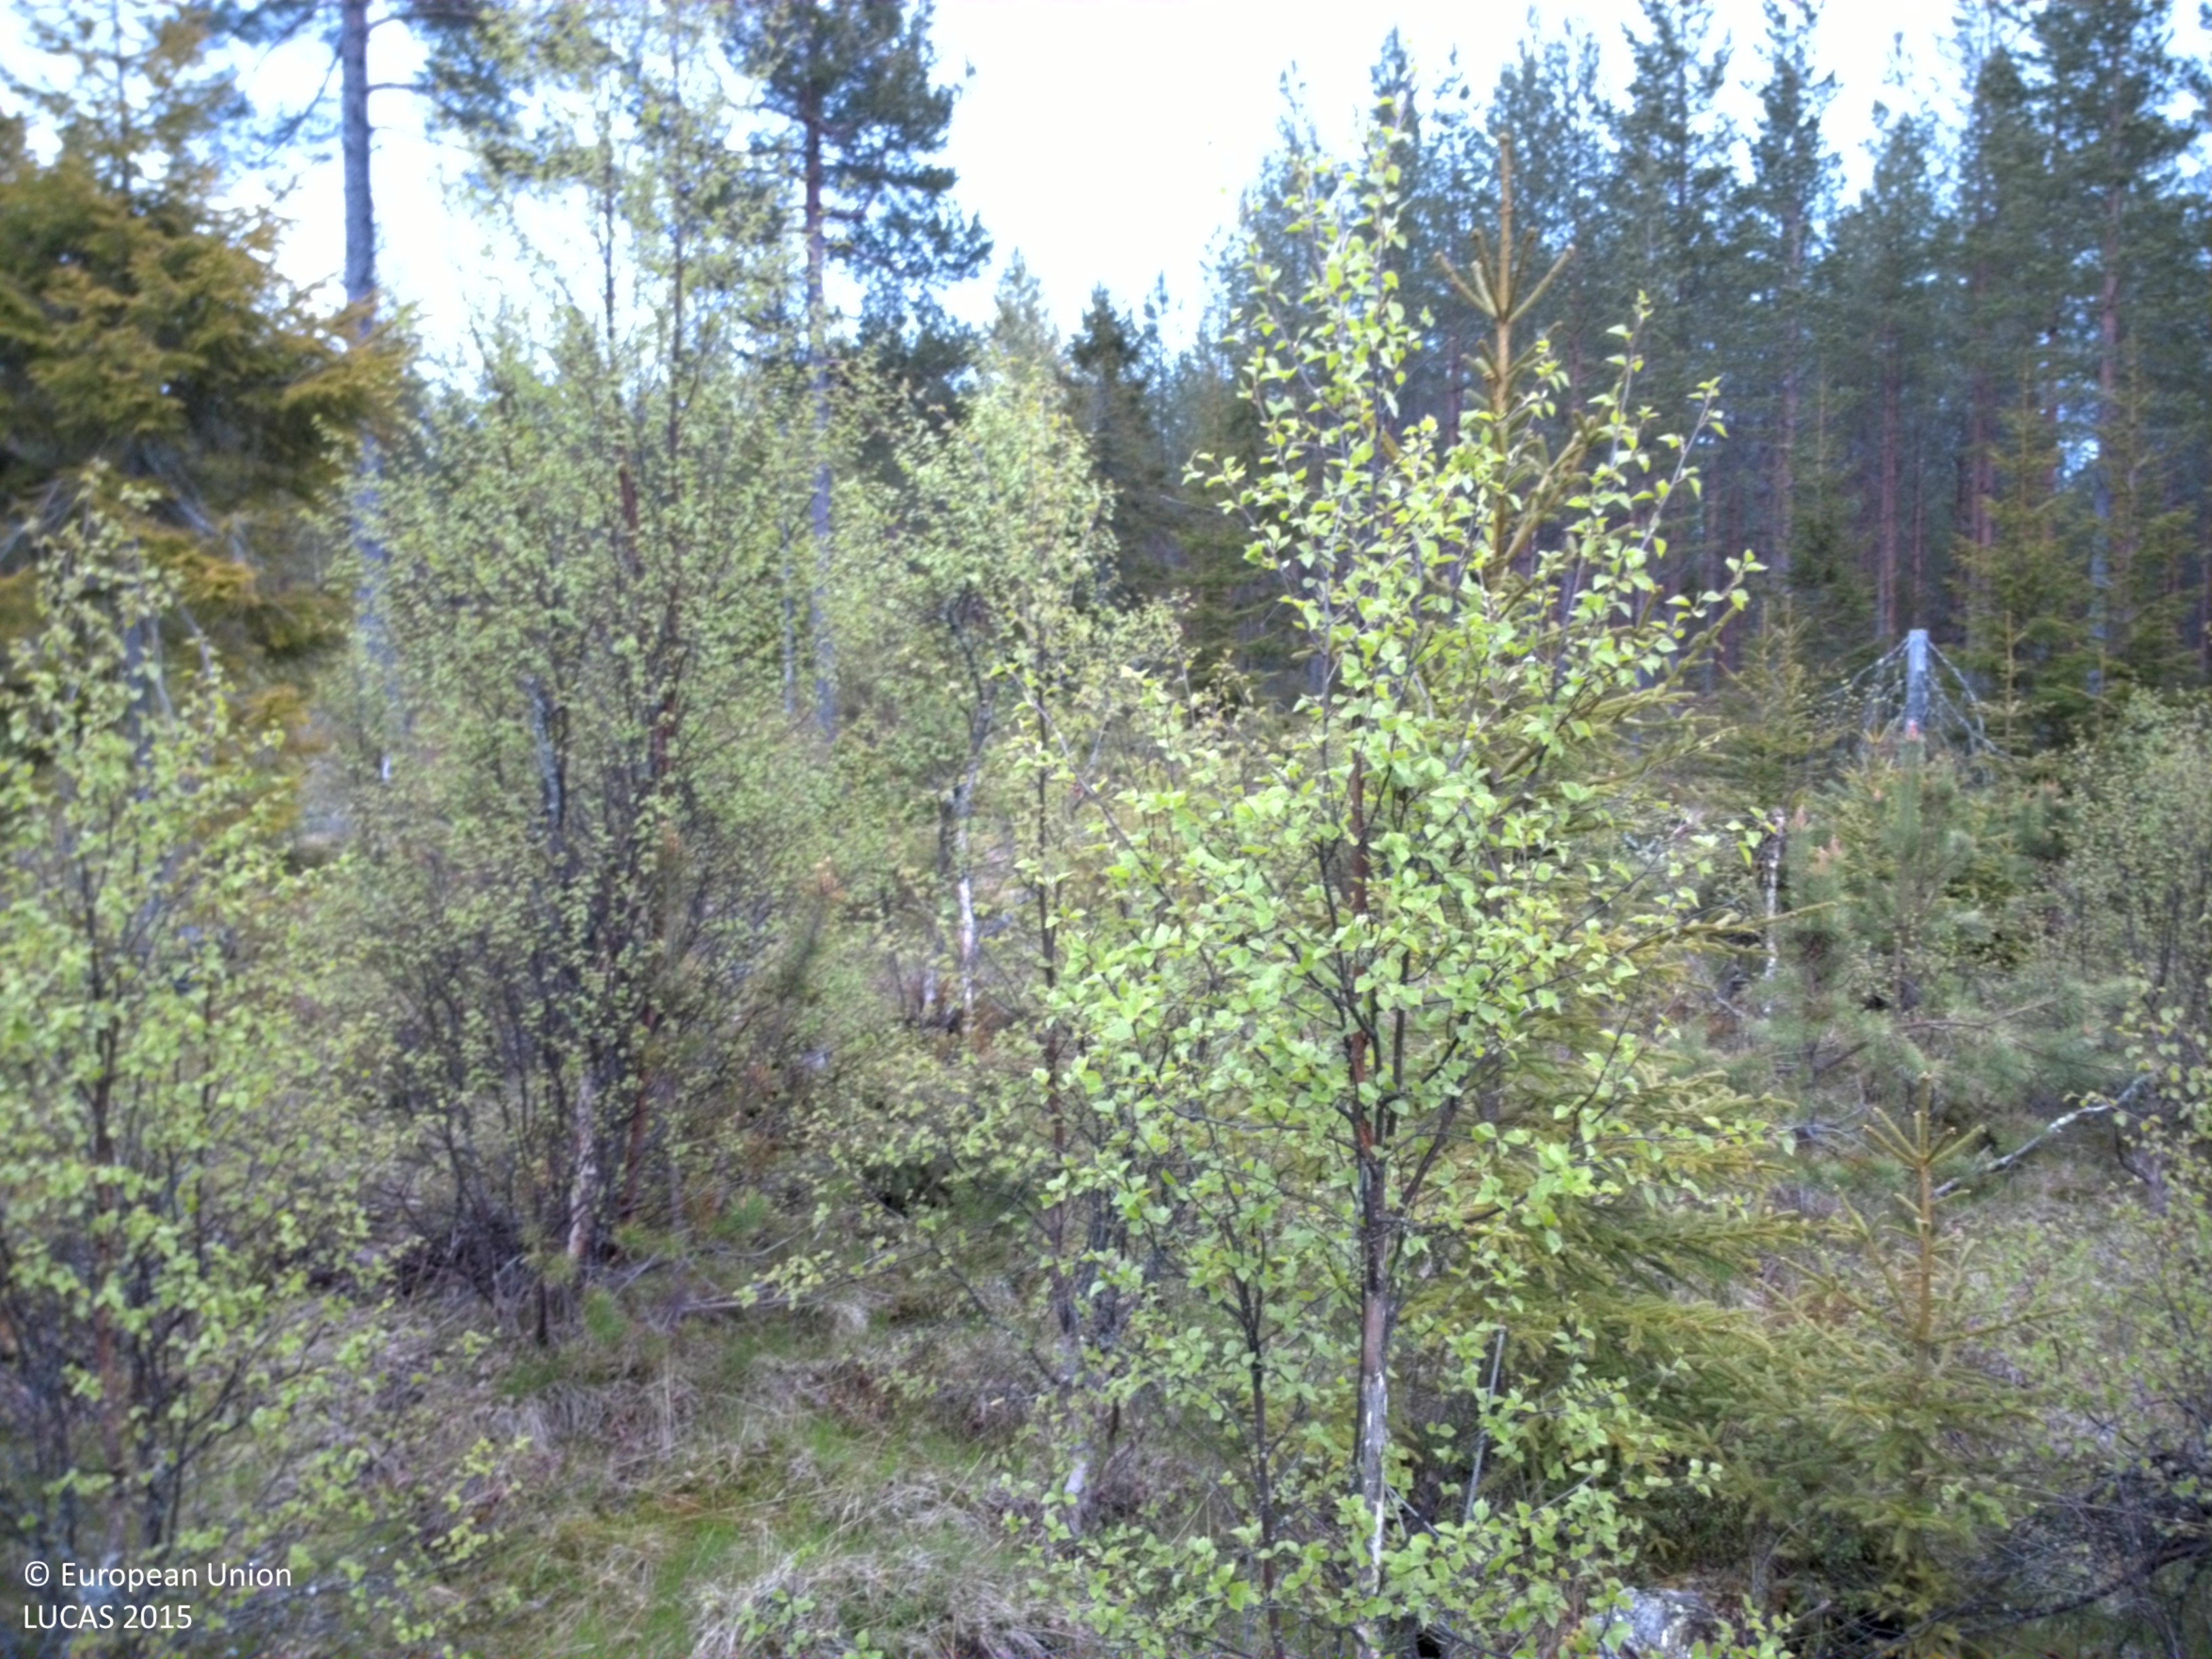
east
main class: Woodland
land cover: Pine dominated mixed woodland
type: boreal forest
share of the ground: 50 - 75 %
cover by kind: coniferous forest trees 50 %, broadleaved forest trees 25 %, herbaceous plants 25 %
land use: Forestry
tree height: < 5 m
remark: Clear cut
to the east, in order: Pine dominated mixed woodland; Pine dominated coniferous woodland; Tracks; Spruce dominated coniferous woodland; Tracks; Spruce dominated mixed woodland; Peatbogs
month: May
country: SE
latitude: 61.1608
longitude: 15.3935
